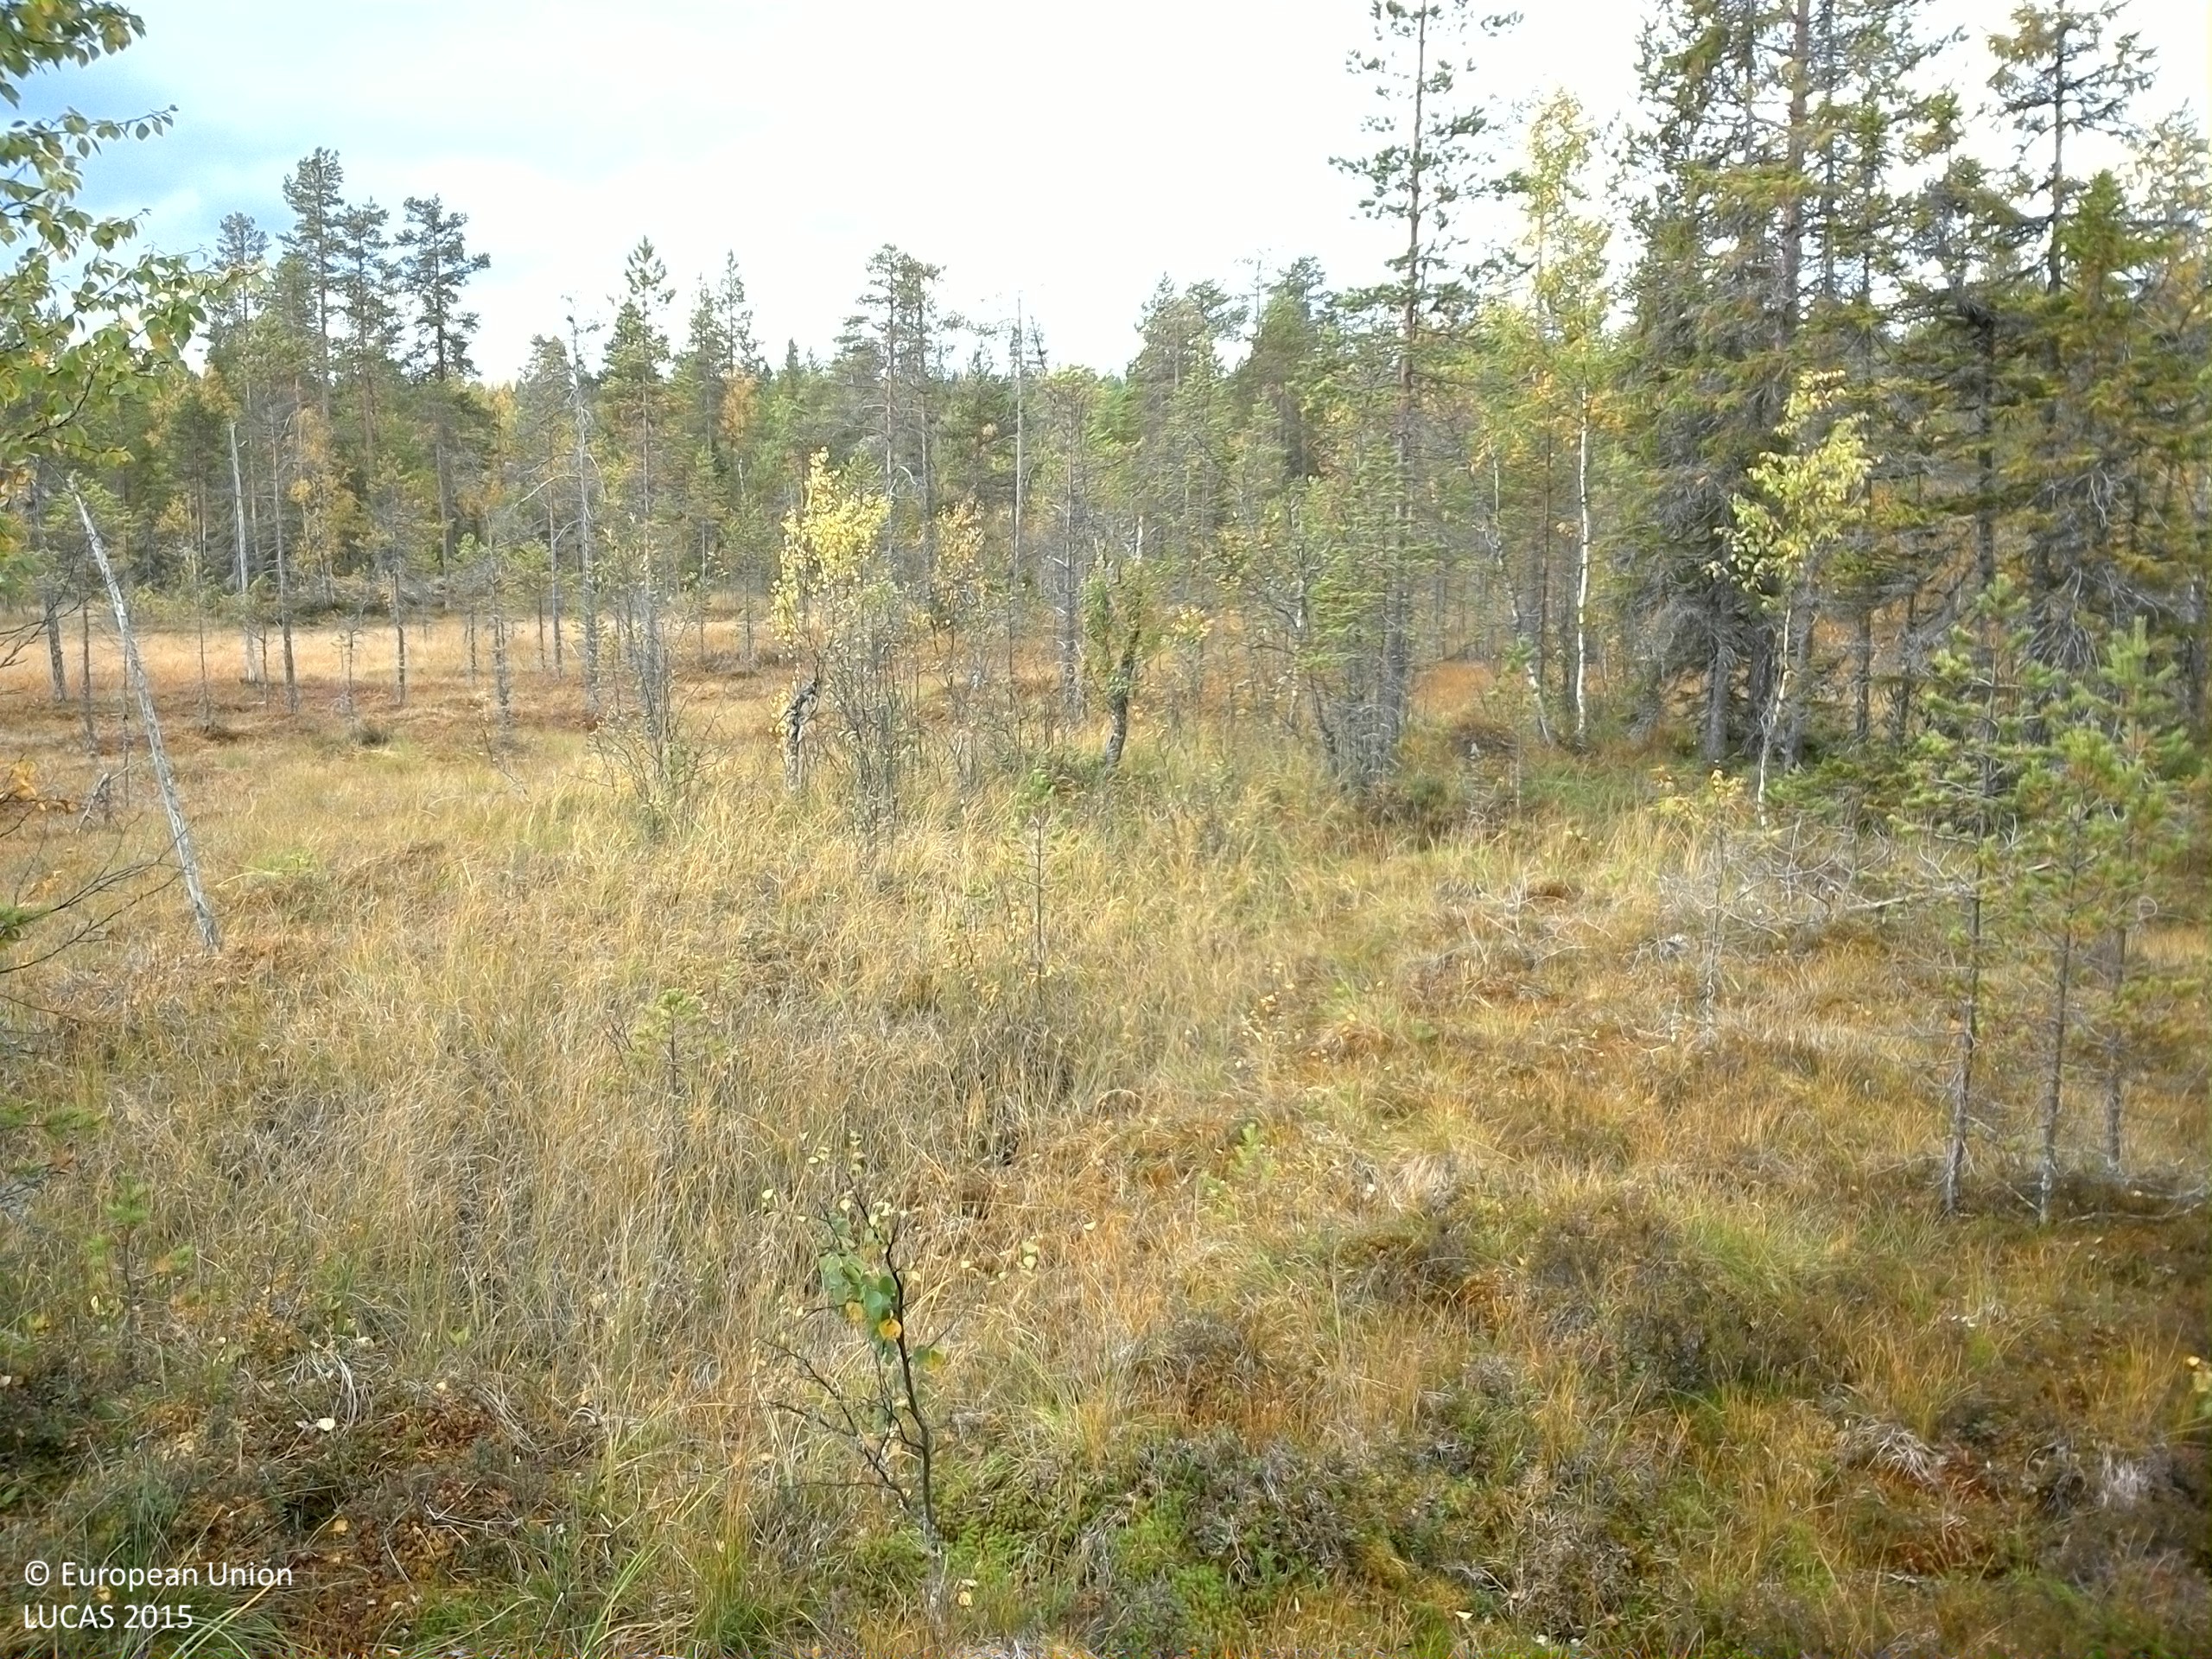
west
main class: Woodland
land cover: Pine dominated coniferous woodland
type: boreal forest
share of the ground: 10 - 25 %
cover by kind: lichens and mosses 35 %, shrubs 30 %, coniferous forest trees 15 %, herbaceous plants 15 %, broadleaved forest trees 5 %
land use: Forestry
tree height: < 5 m
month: September
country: SE
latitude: 61.5934
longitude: 14.9022
